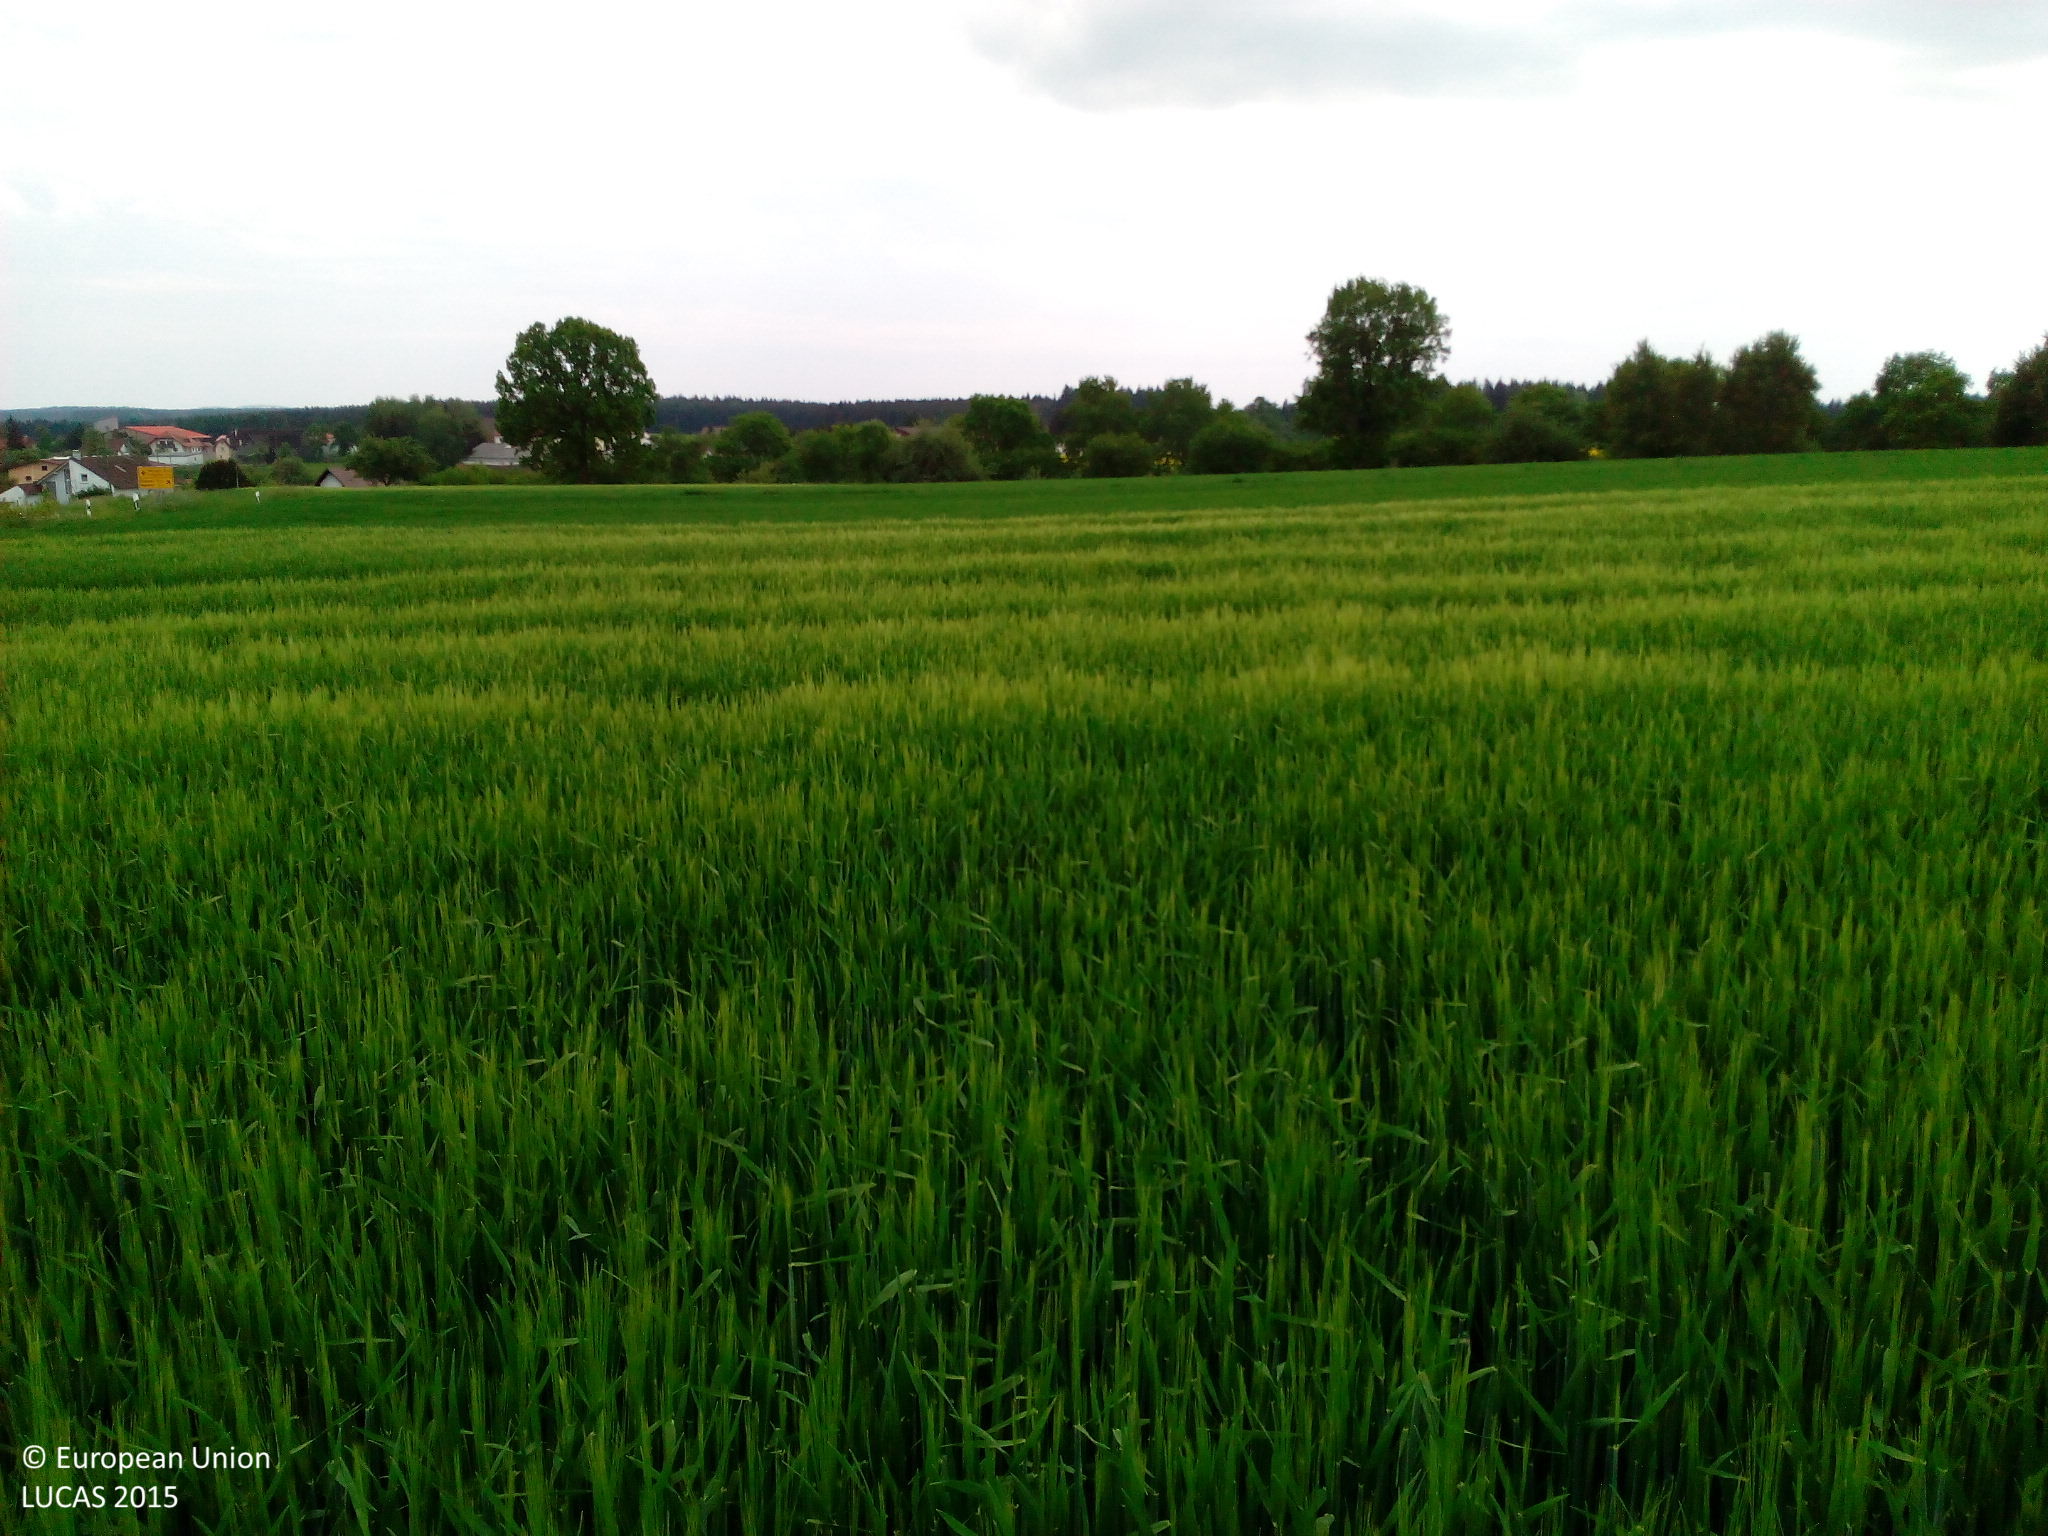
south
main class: Cropland
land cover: Barley
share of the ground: > 75 %
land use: Agriculture (excluding fallow land and kitchen gardens)
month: May
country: DE
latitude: 47.9875
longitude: 9.3171
